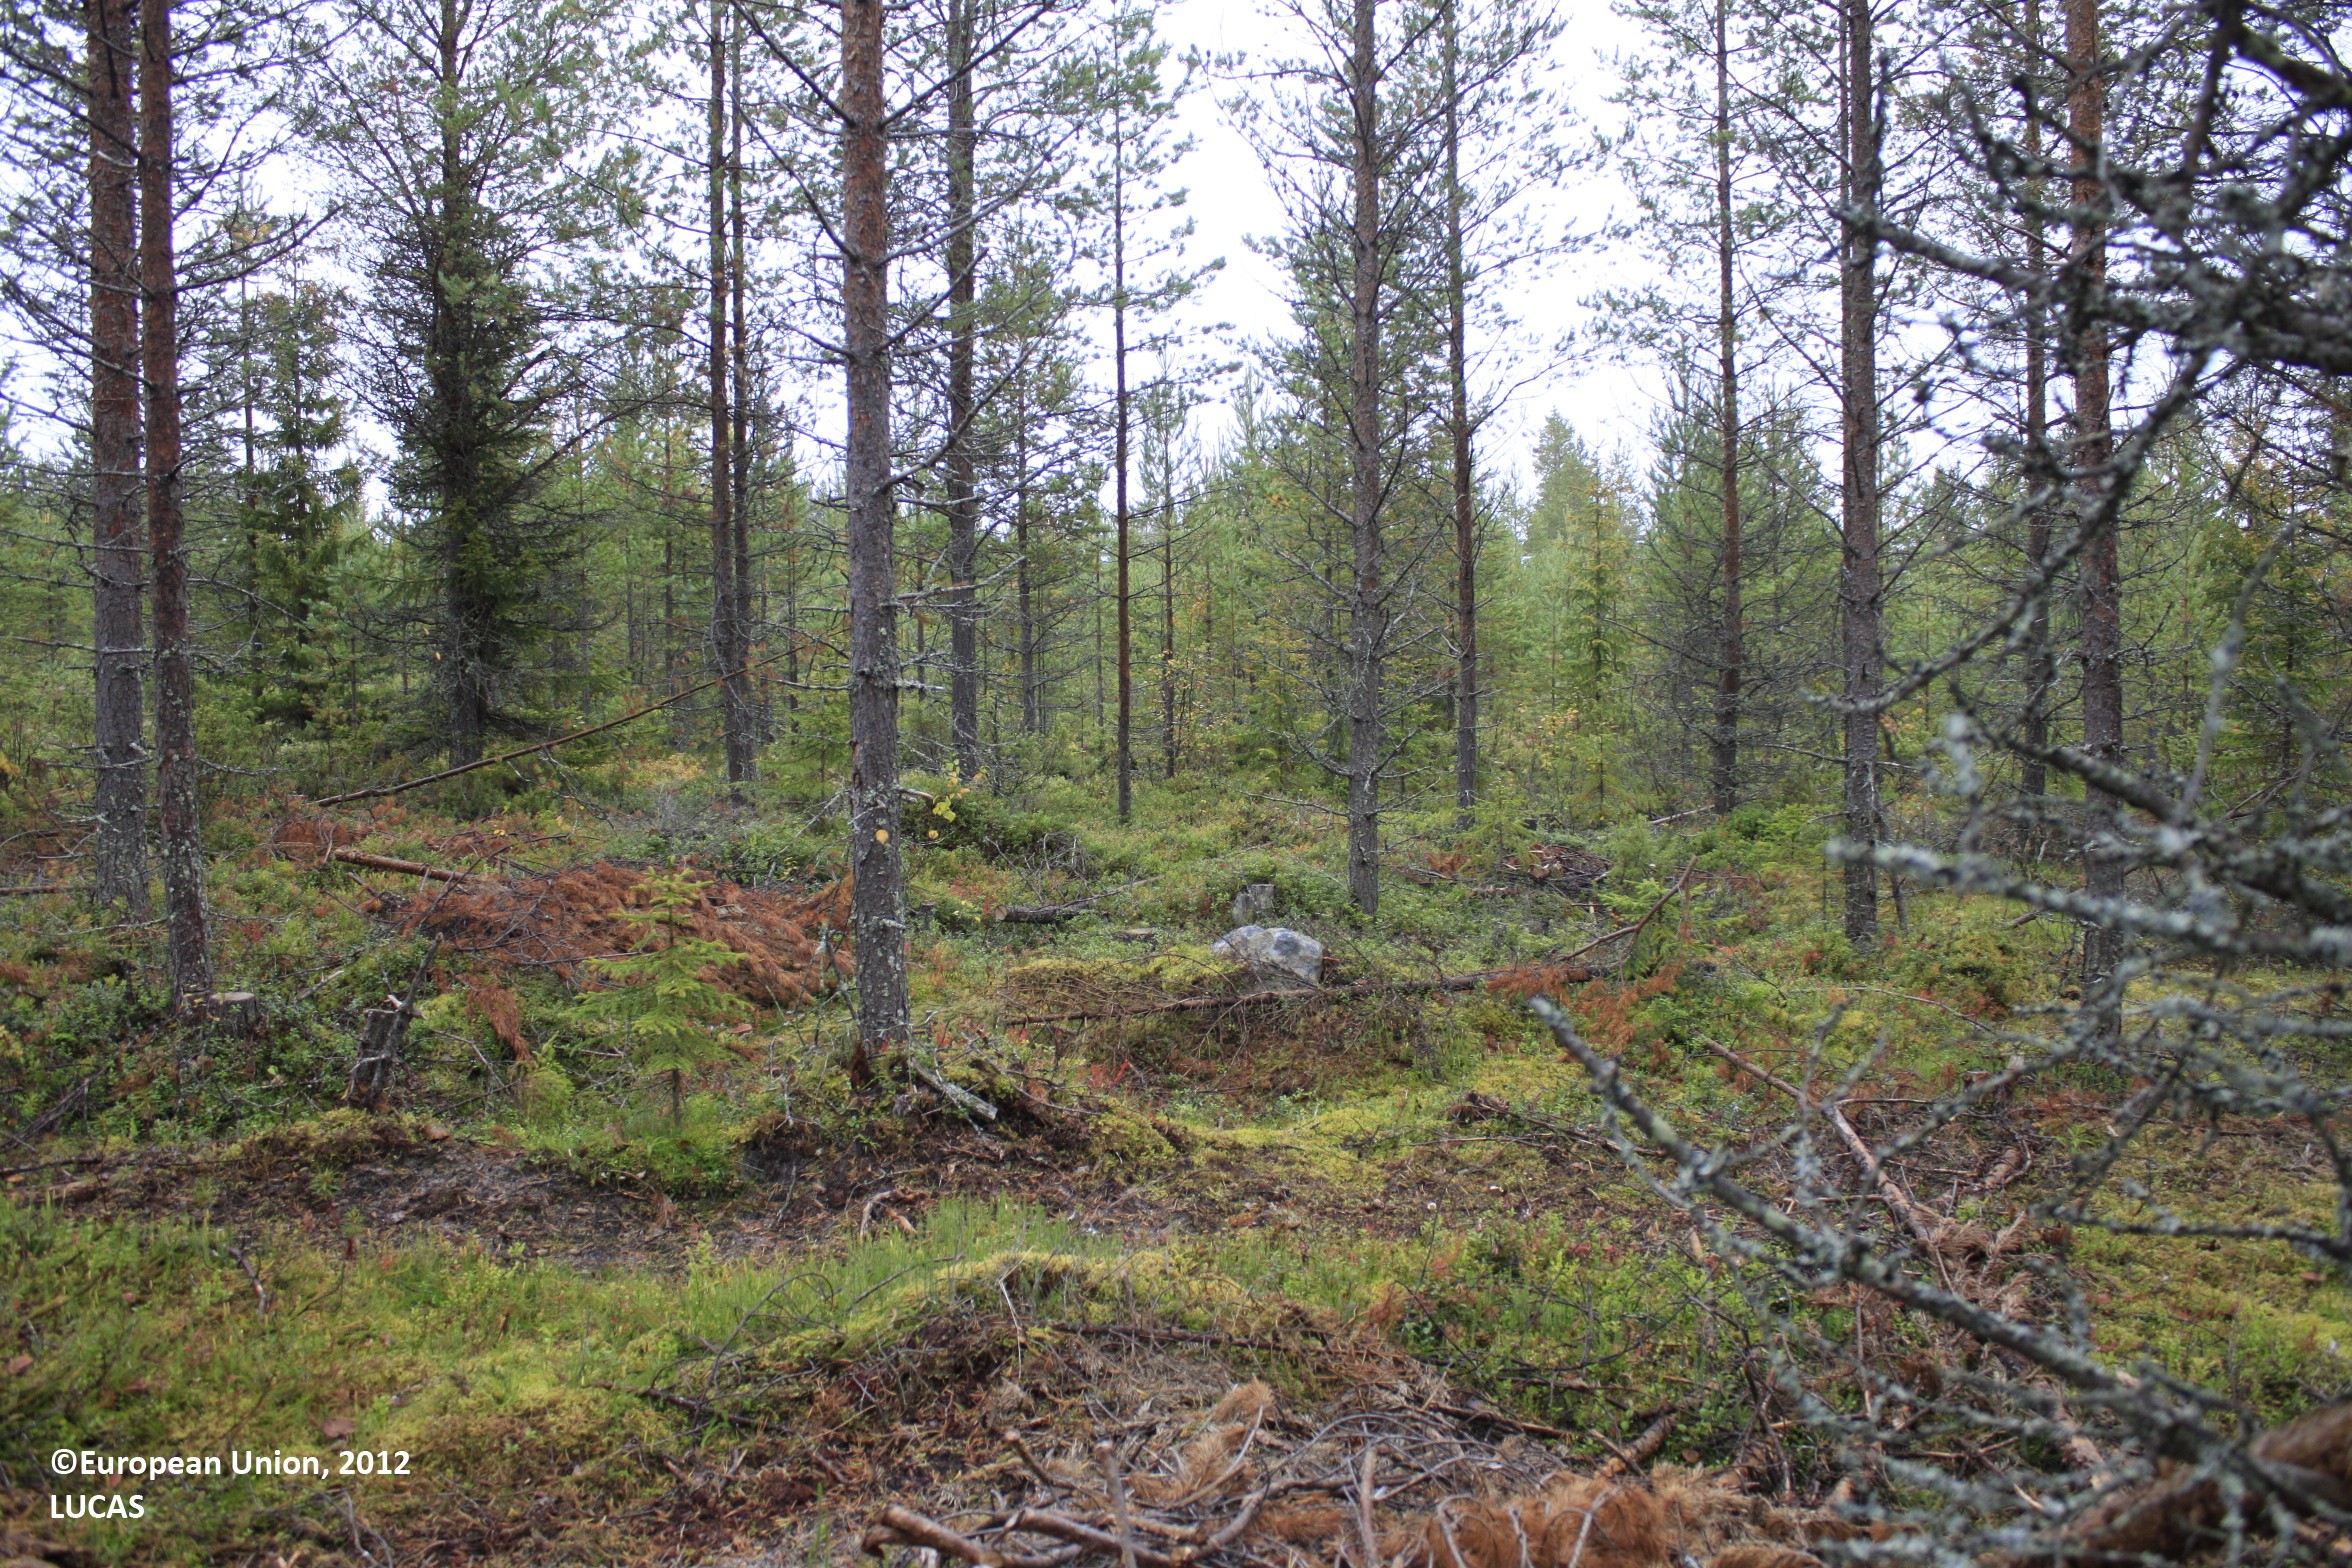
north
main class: Woodland
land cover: Pine dominated coniferous woodland
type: boreal forest
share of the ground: 25 - 50 %
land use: Forestry
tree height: > 5 m
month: September
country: FI
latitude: 65.8503
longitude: 27.1788
